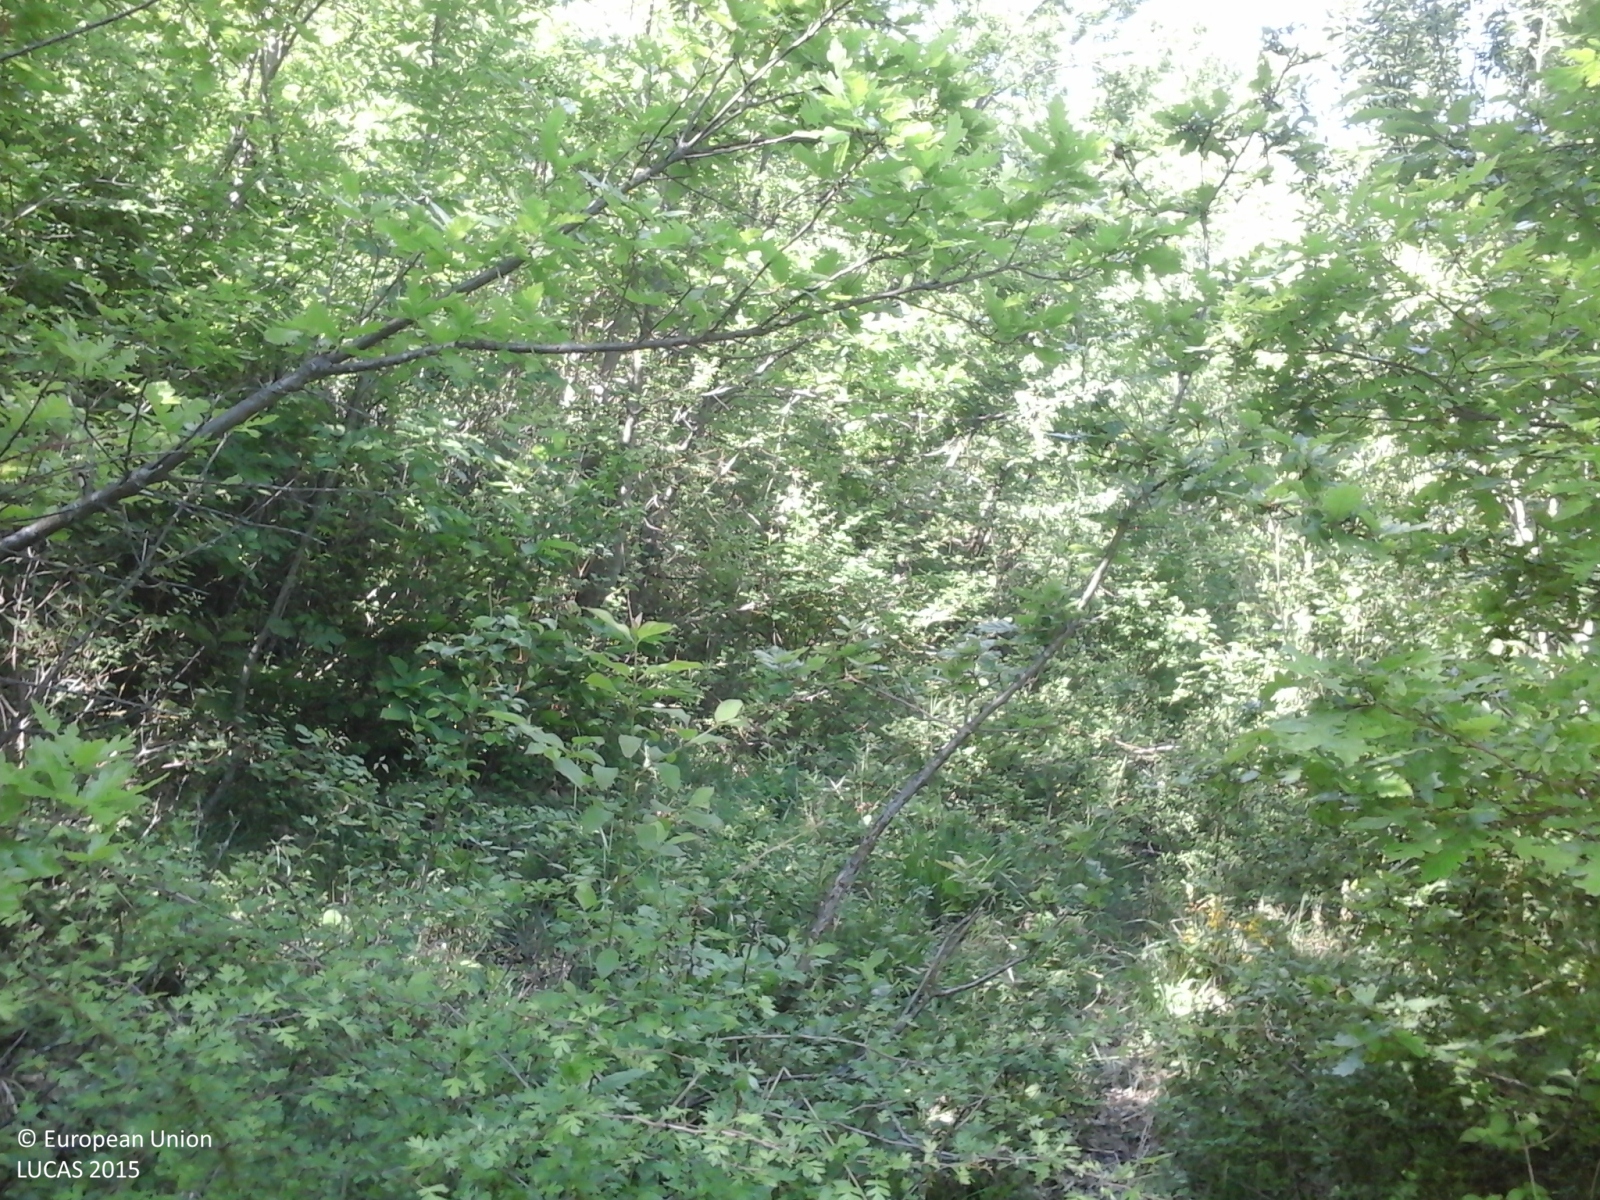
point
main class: Woodland
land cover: Broadleaved woodland
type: mesophytic deciduous forest
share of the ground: > 75 %
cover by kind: broadleaved forest trees 90 %, shrubs 5 %, herbaceous plants 5 %
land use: Forestry
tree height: > 5 m
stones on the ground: < 10 %
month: May
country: IT
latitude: 44.4582
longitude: 9.6614
